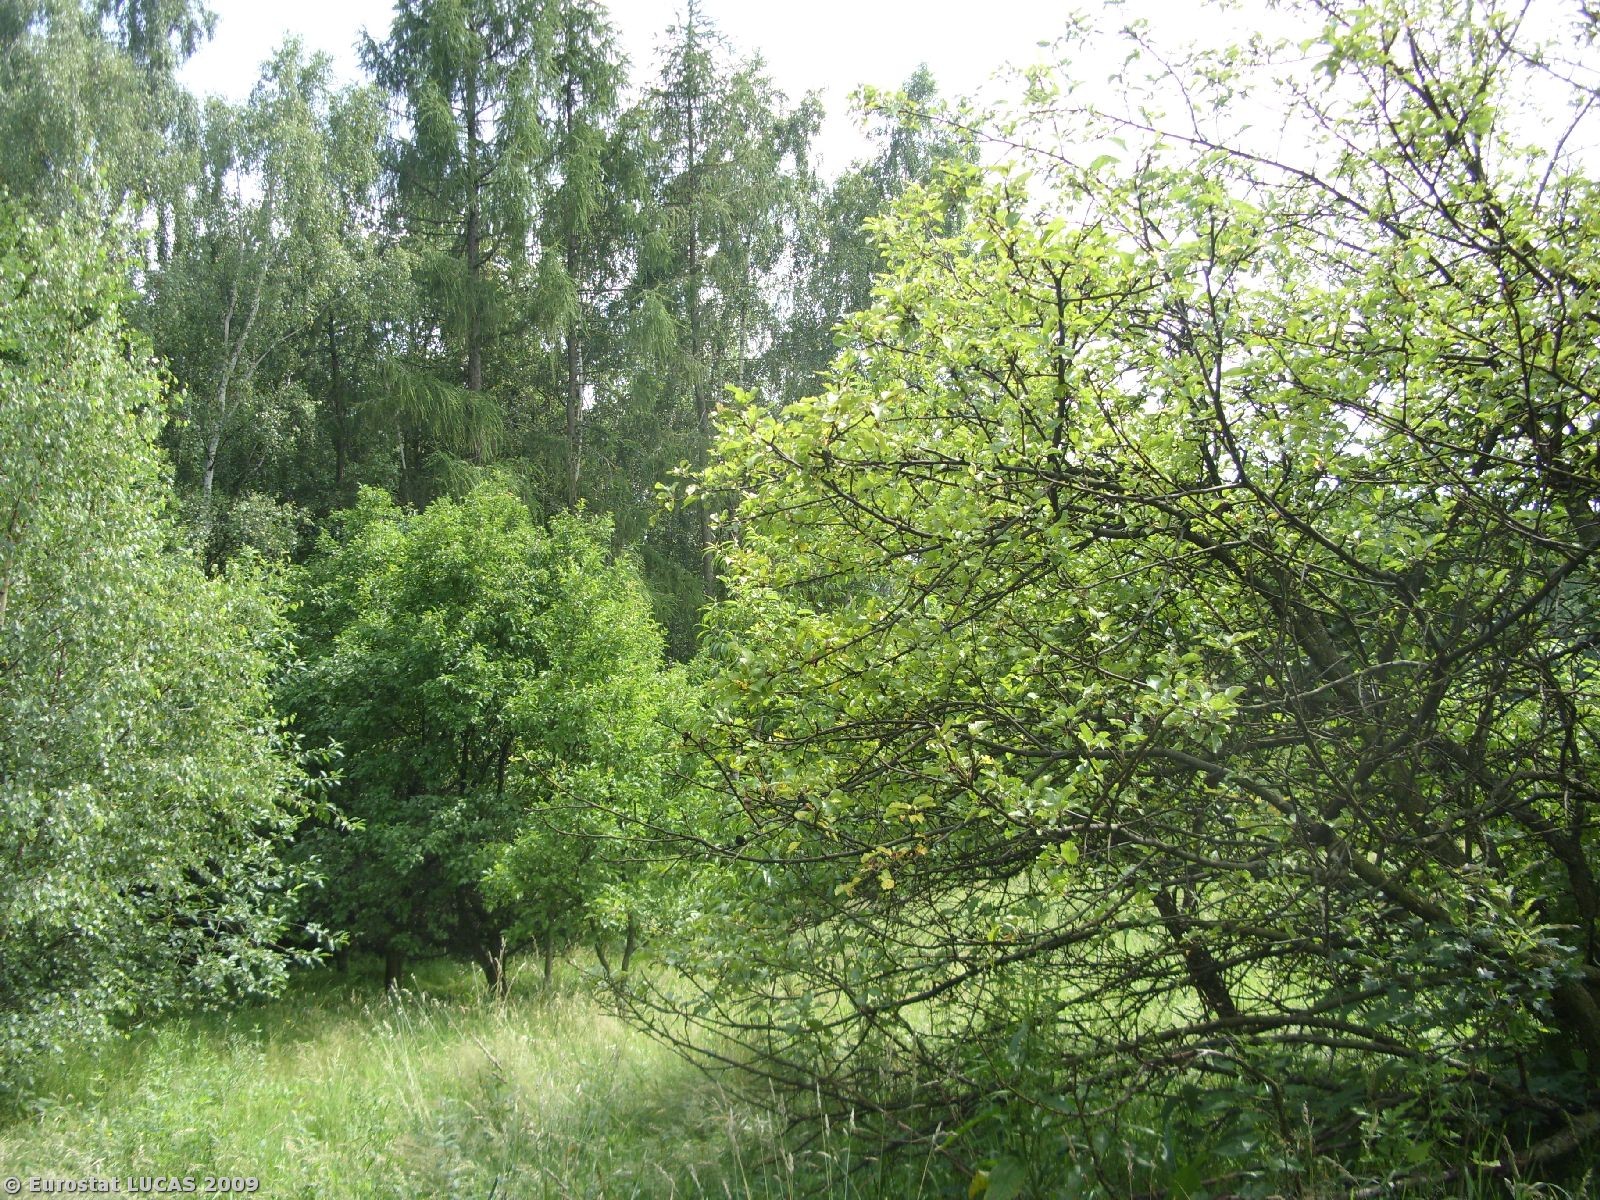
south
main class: Grassland
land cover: Grassland with sparse tree/shrub cover
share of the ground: > 75 %
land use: Unused
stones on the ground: < 10 %
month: July
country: PL
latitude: 49.8923
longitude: 19.9565
